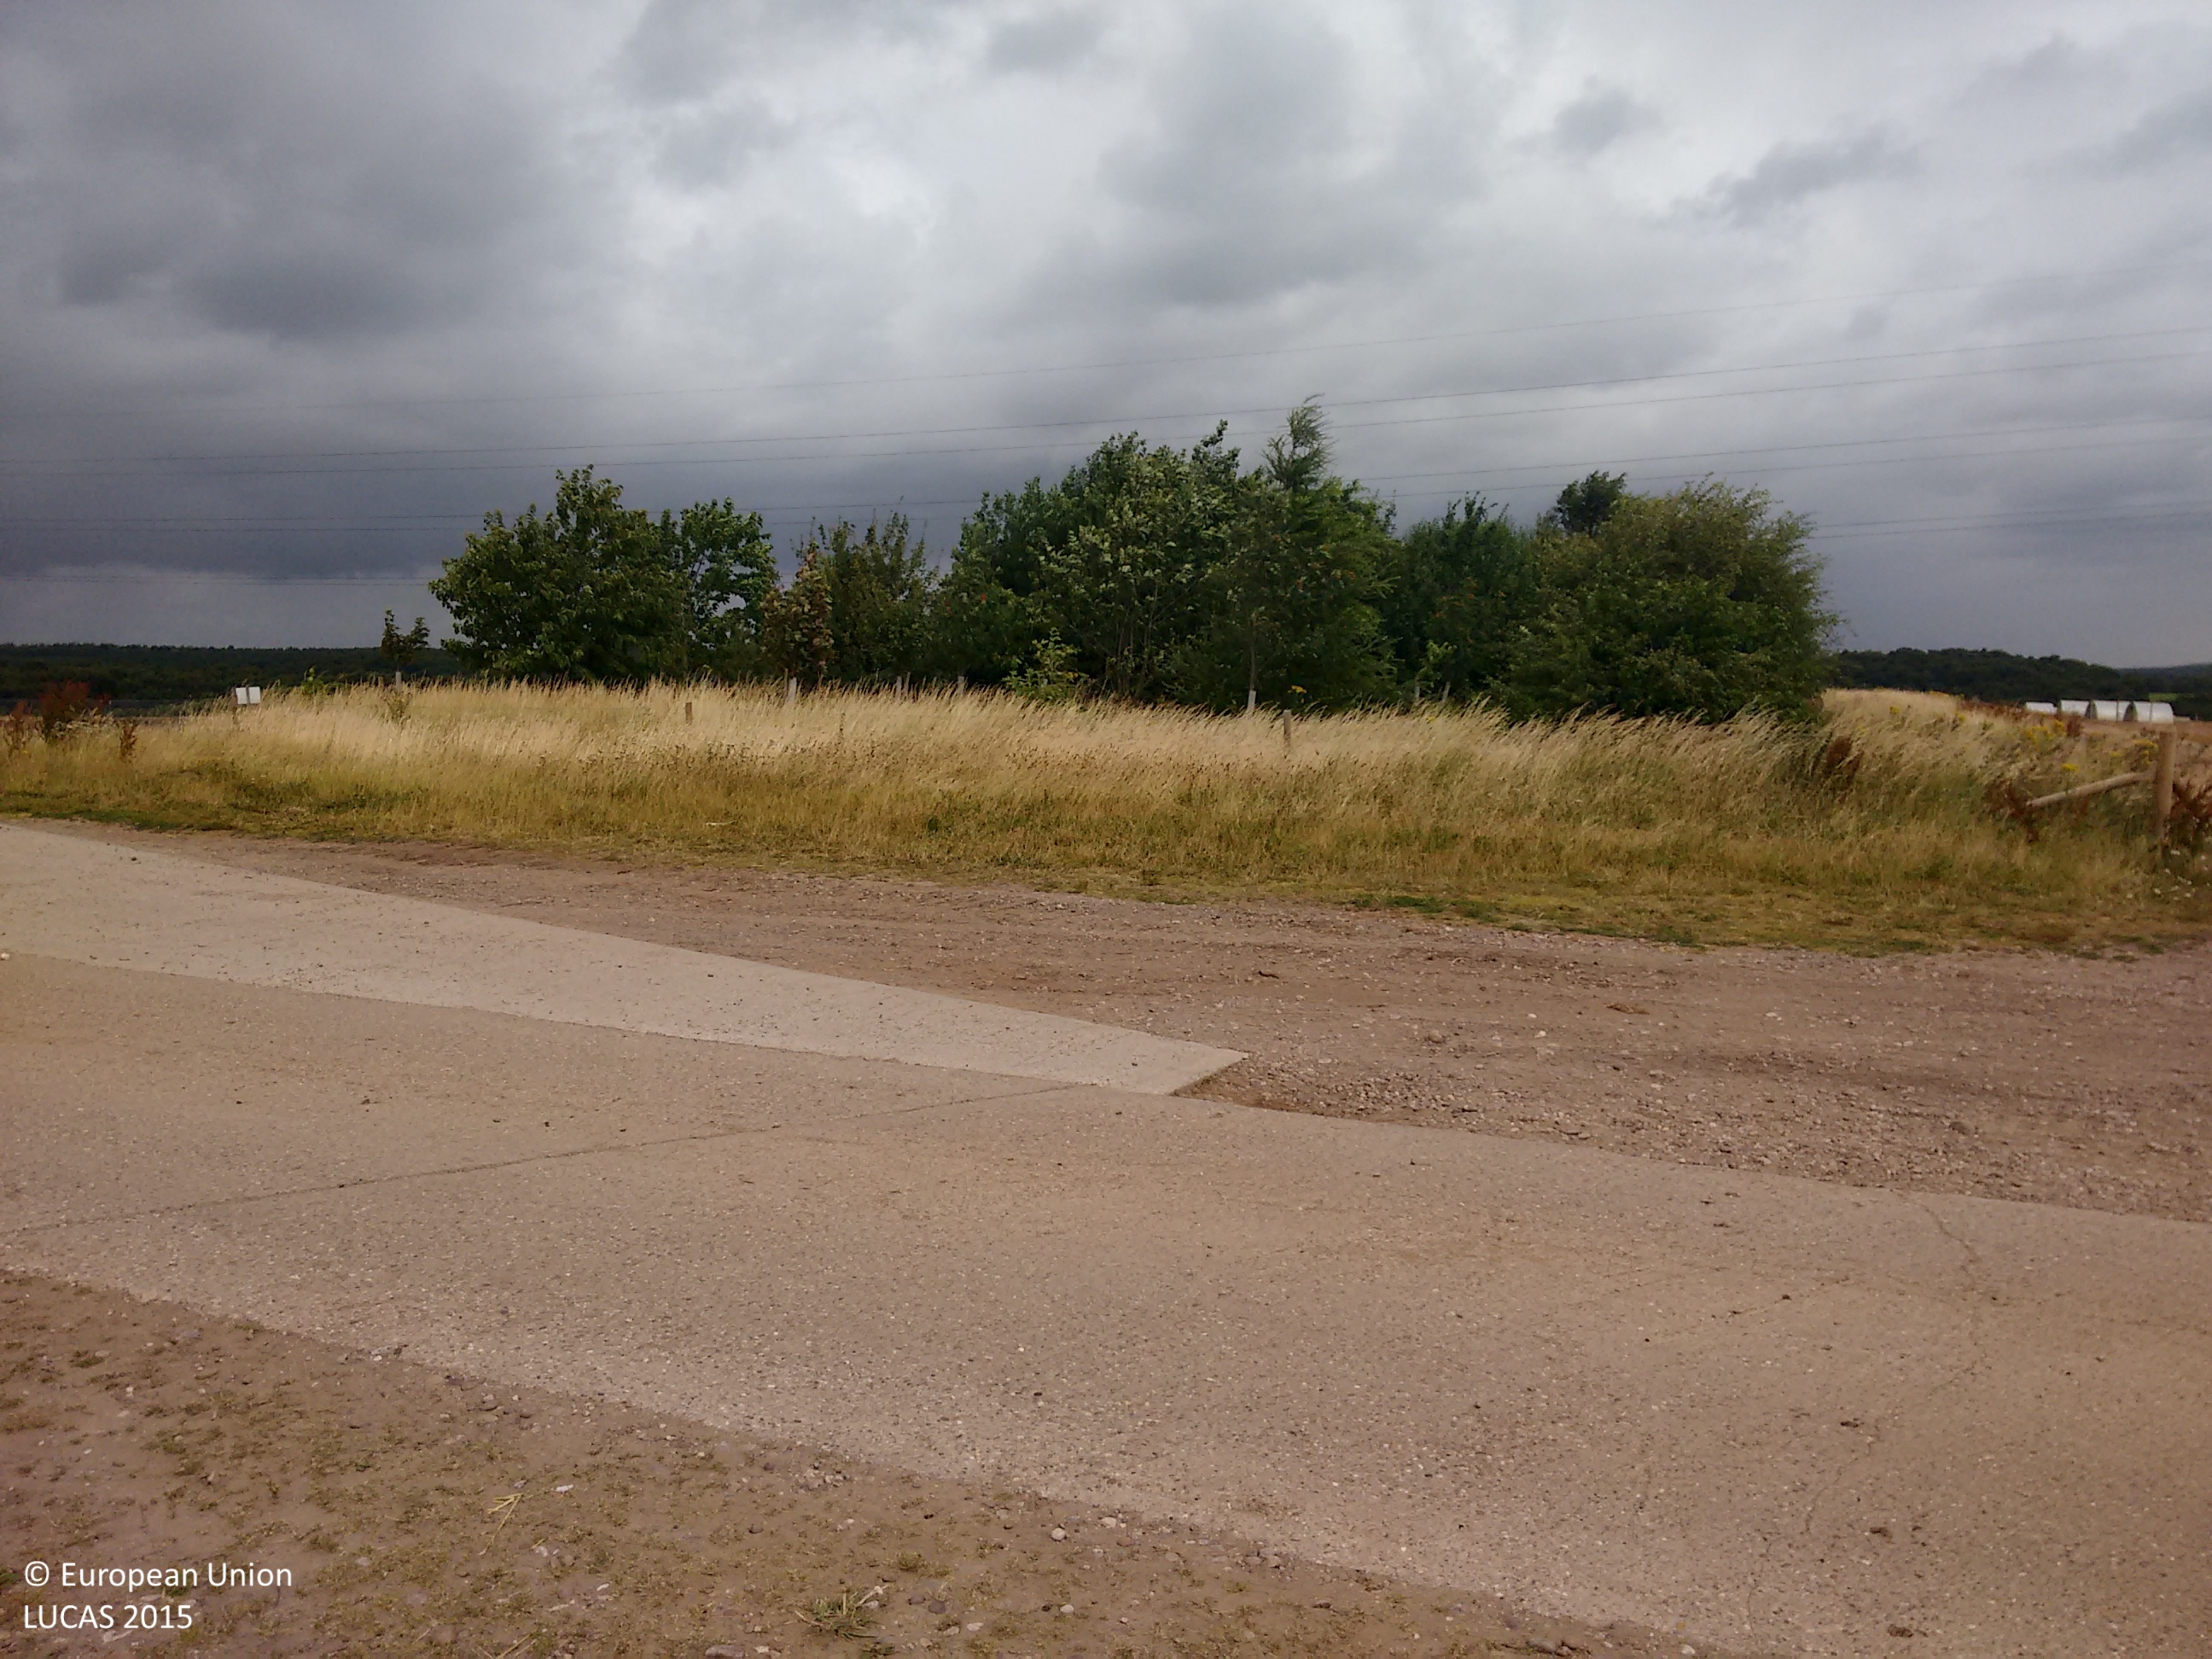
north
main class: Grassland
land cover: Spontaneously vegetated surfaces
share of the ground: > 75 %
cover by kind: herbaceous plants 100 %
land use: Agriculture (excluding fallow land and kitchen gardens)
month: July
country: GB
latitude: 53.1296
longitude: -1.0593
